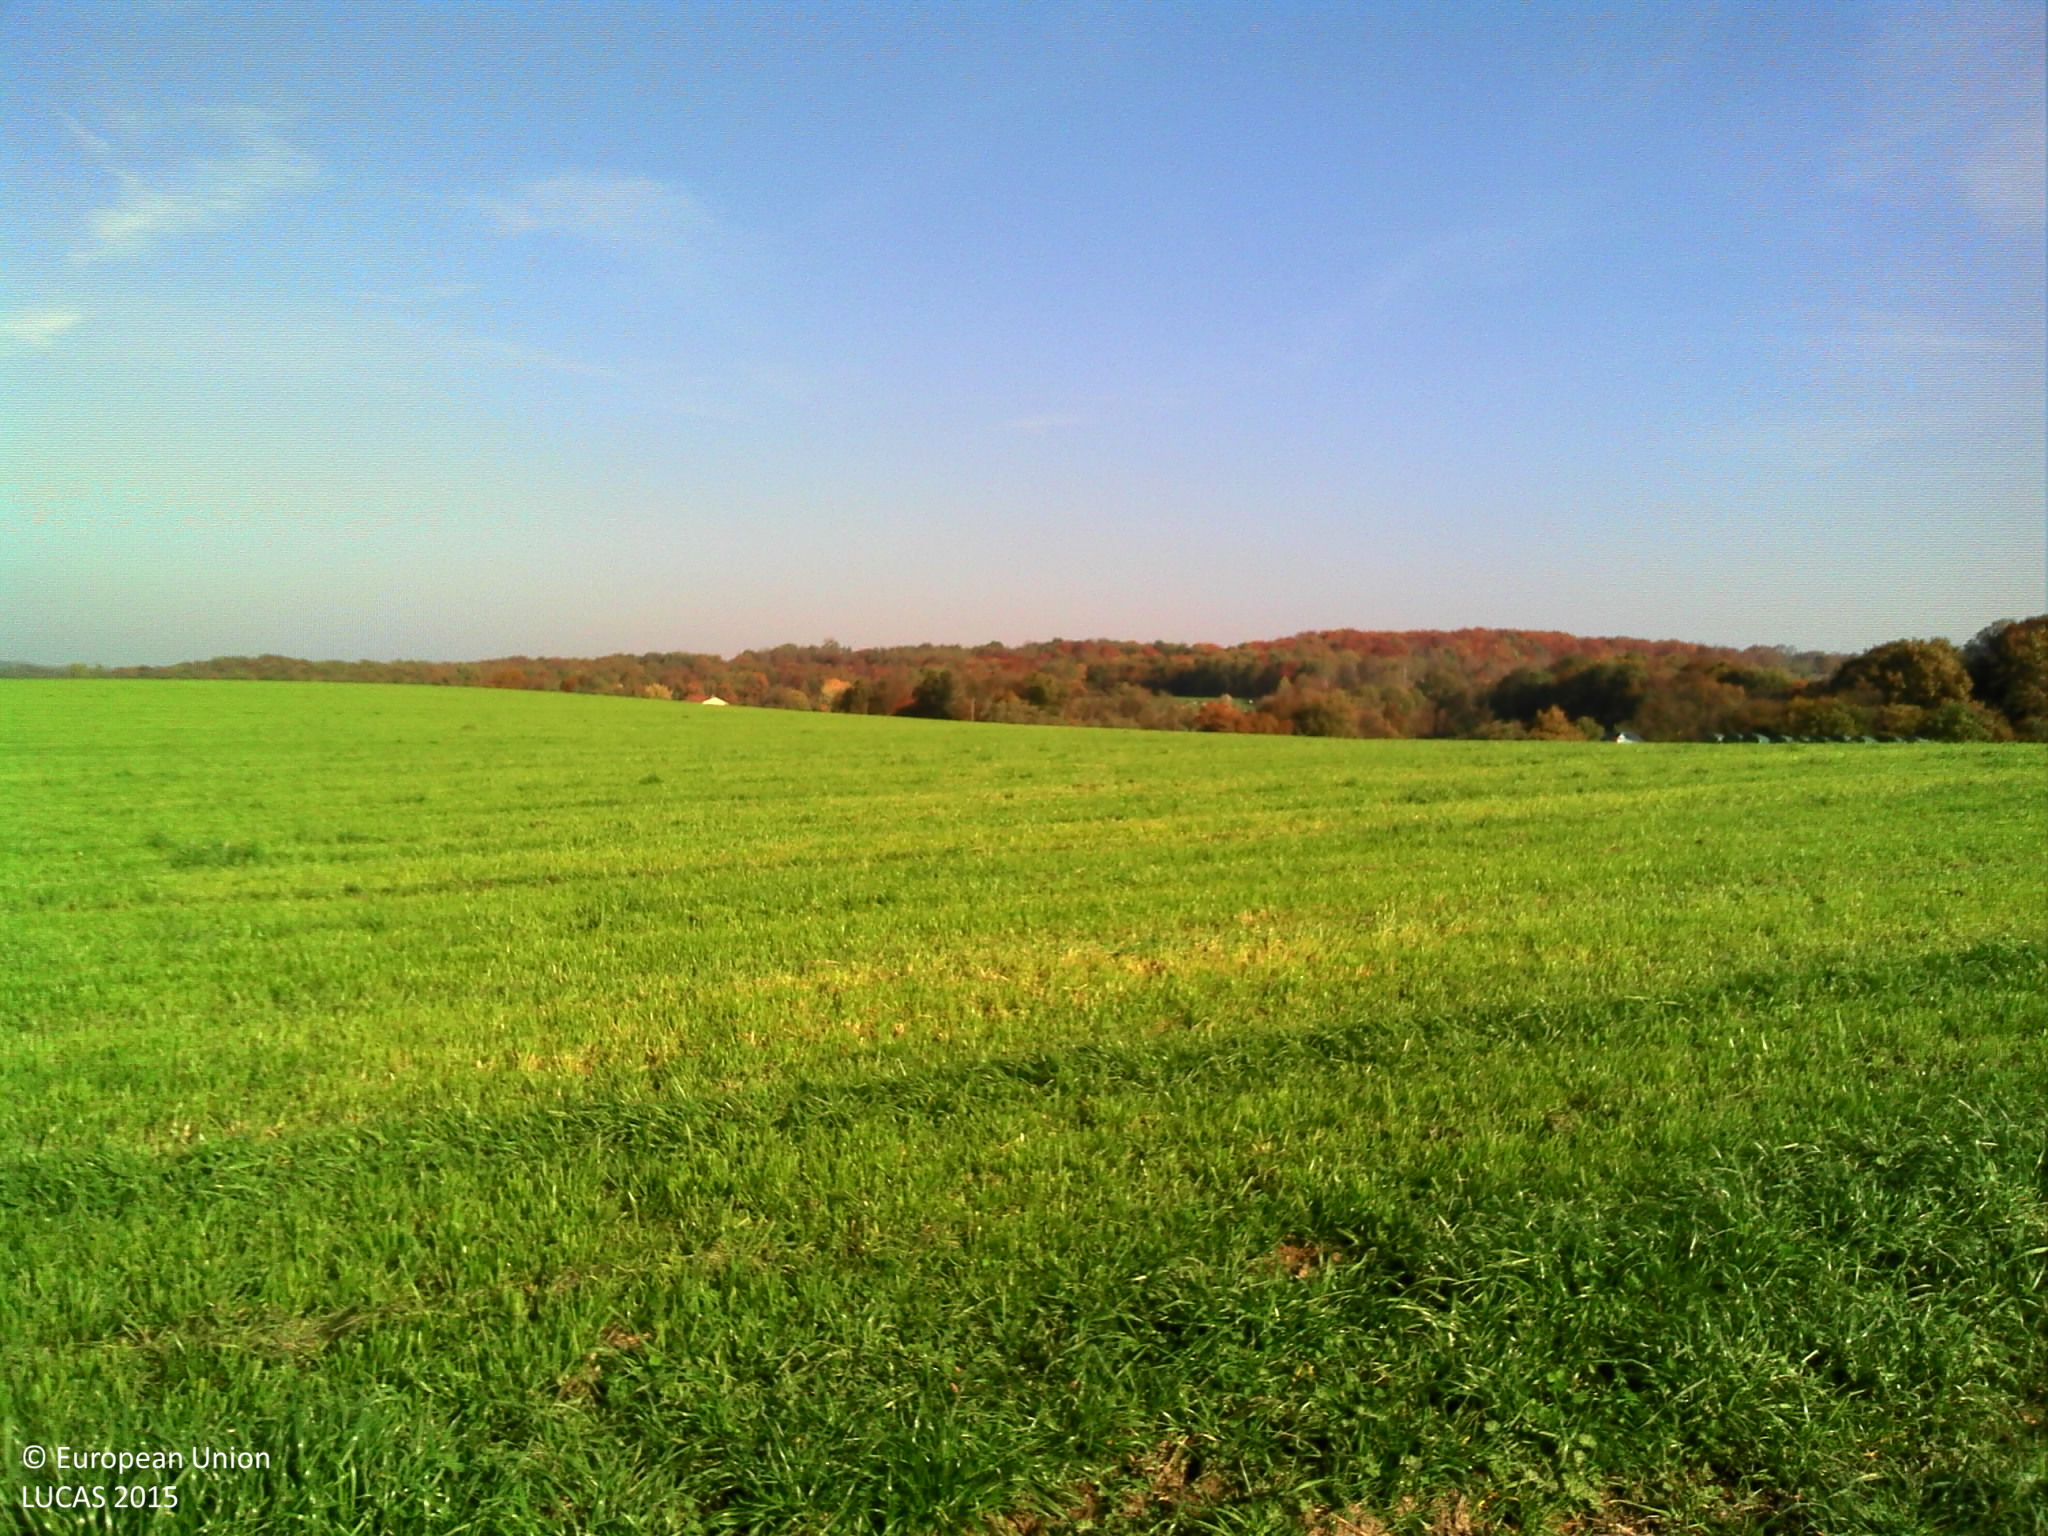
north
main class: Cropland
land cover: Temporary grasslands
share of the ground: > 75 %
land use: Agriculture (excluding fallow land and kitchen gardens)
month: October
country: FR
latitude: 46.0309
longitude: 5.2877
